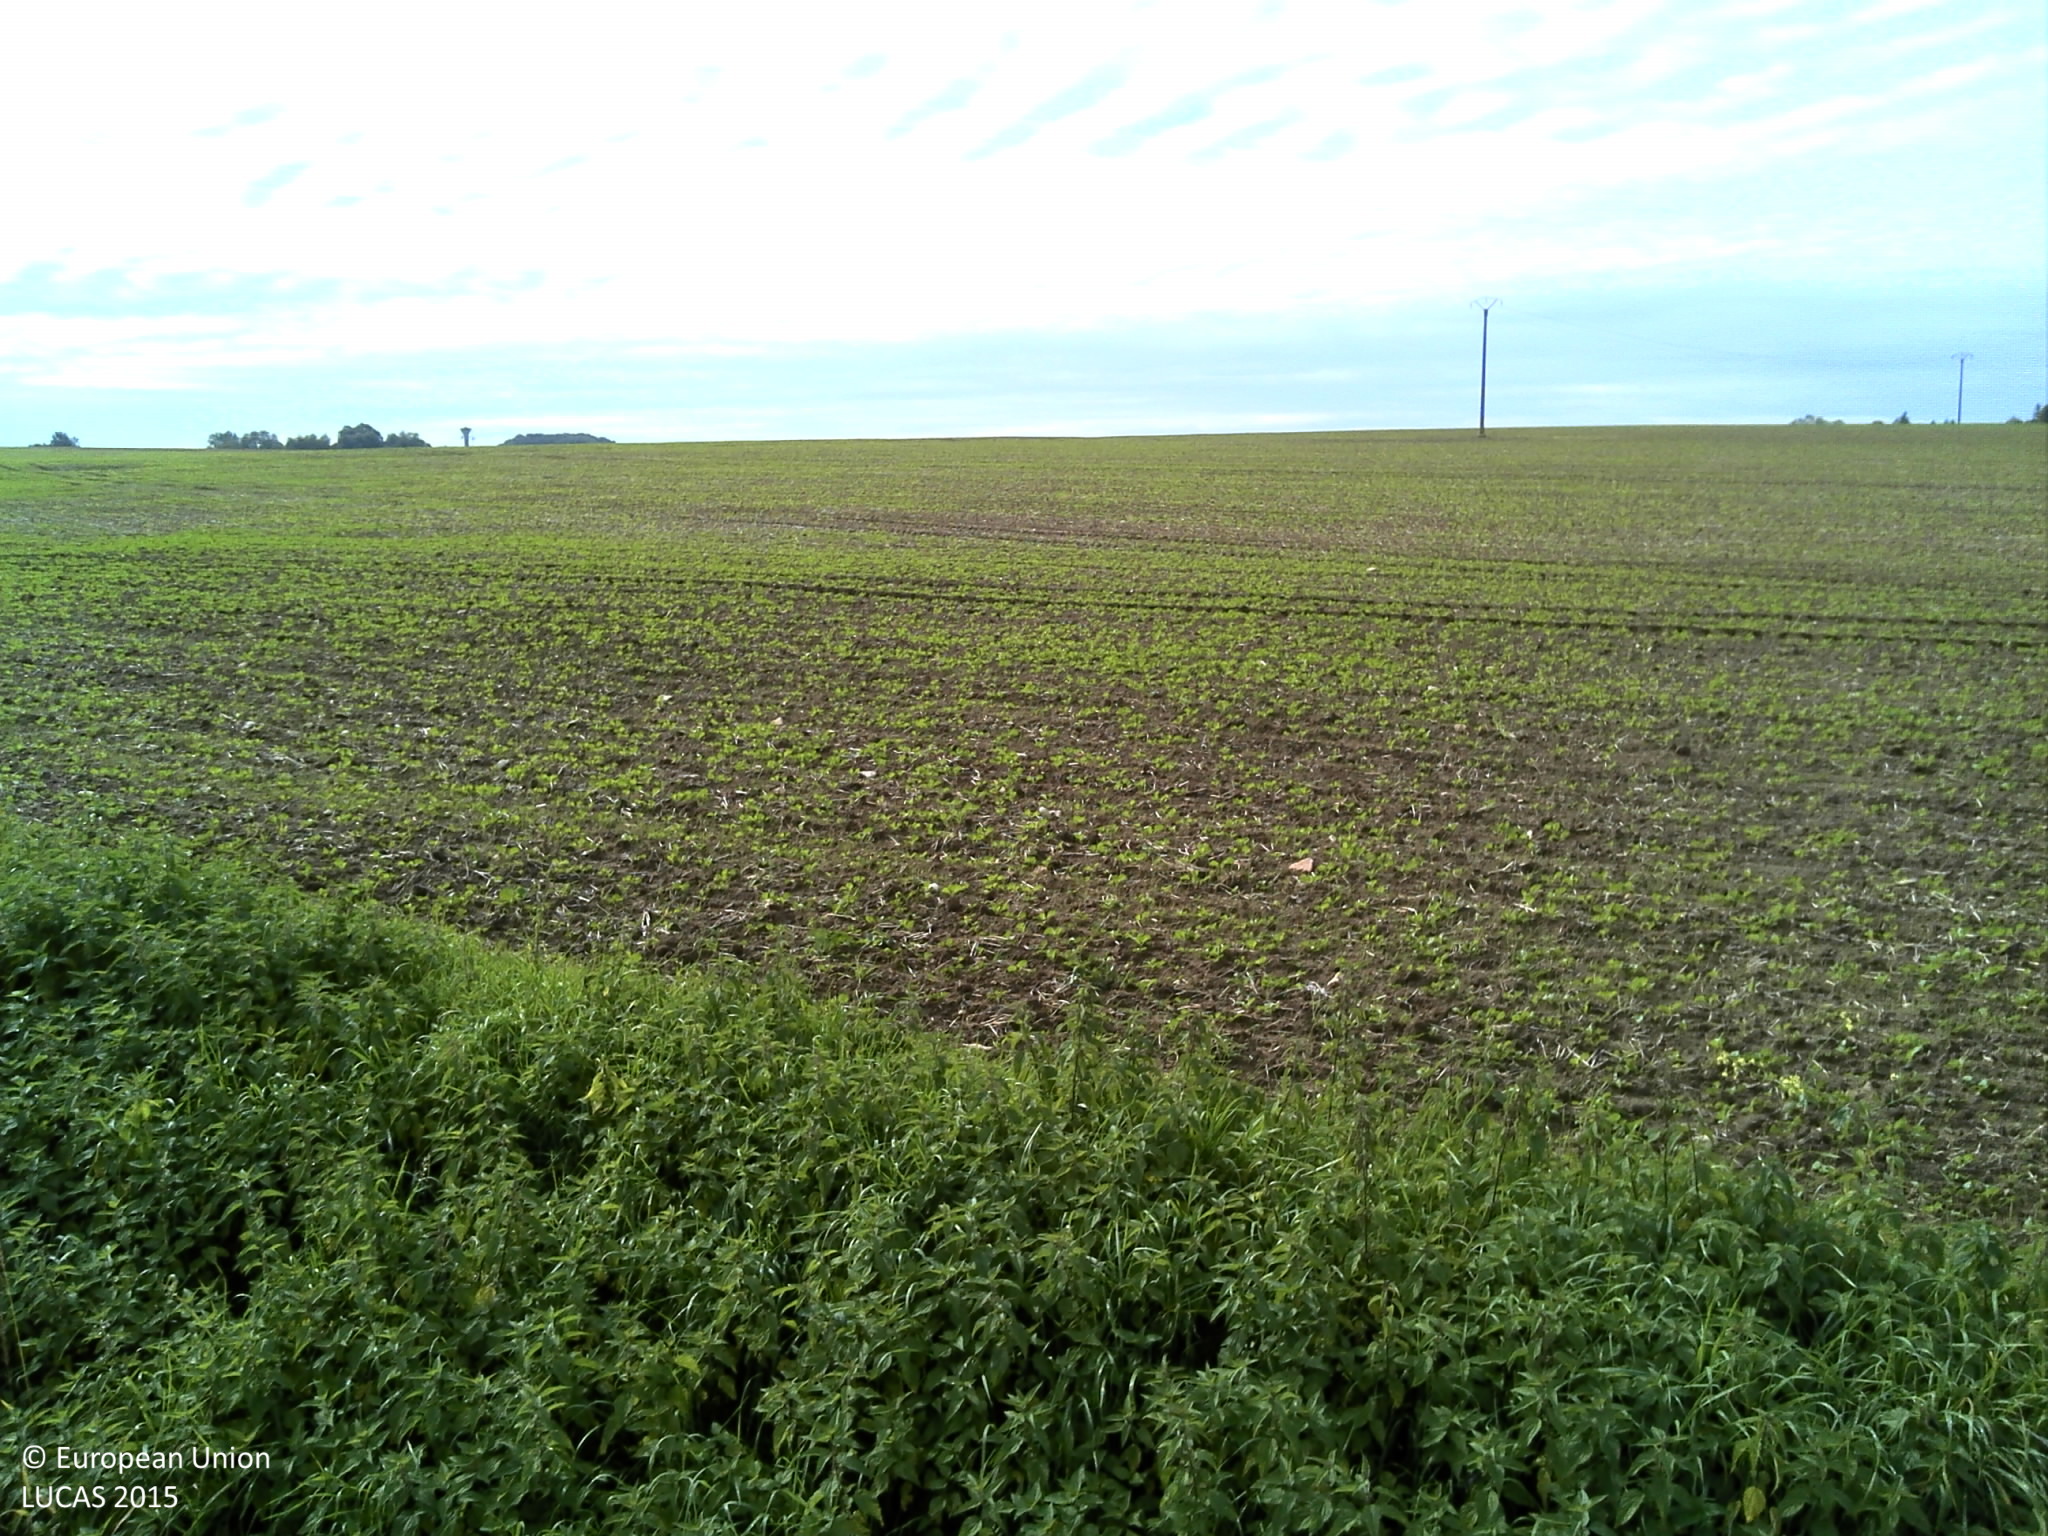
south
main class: Grassland
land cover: Grassland without tree/shrub cover
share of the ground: > 75 %
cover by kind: herbaceous plants 100 %
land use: Semi-natural and natural areas not in use
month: June
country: FR
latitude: 46.7496
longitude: 4.8307
